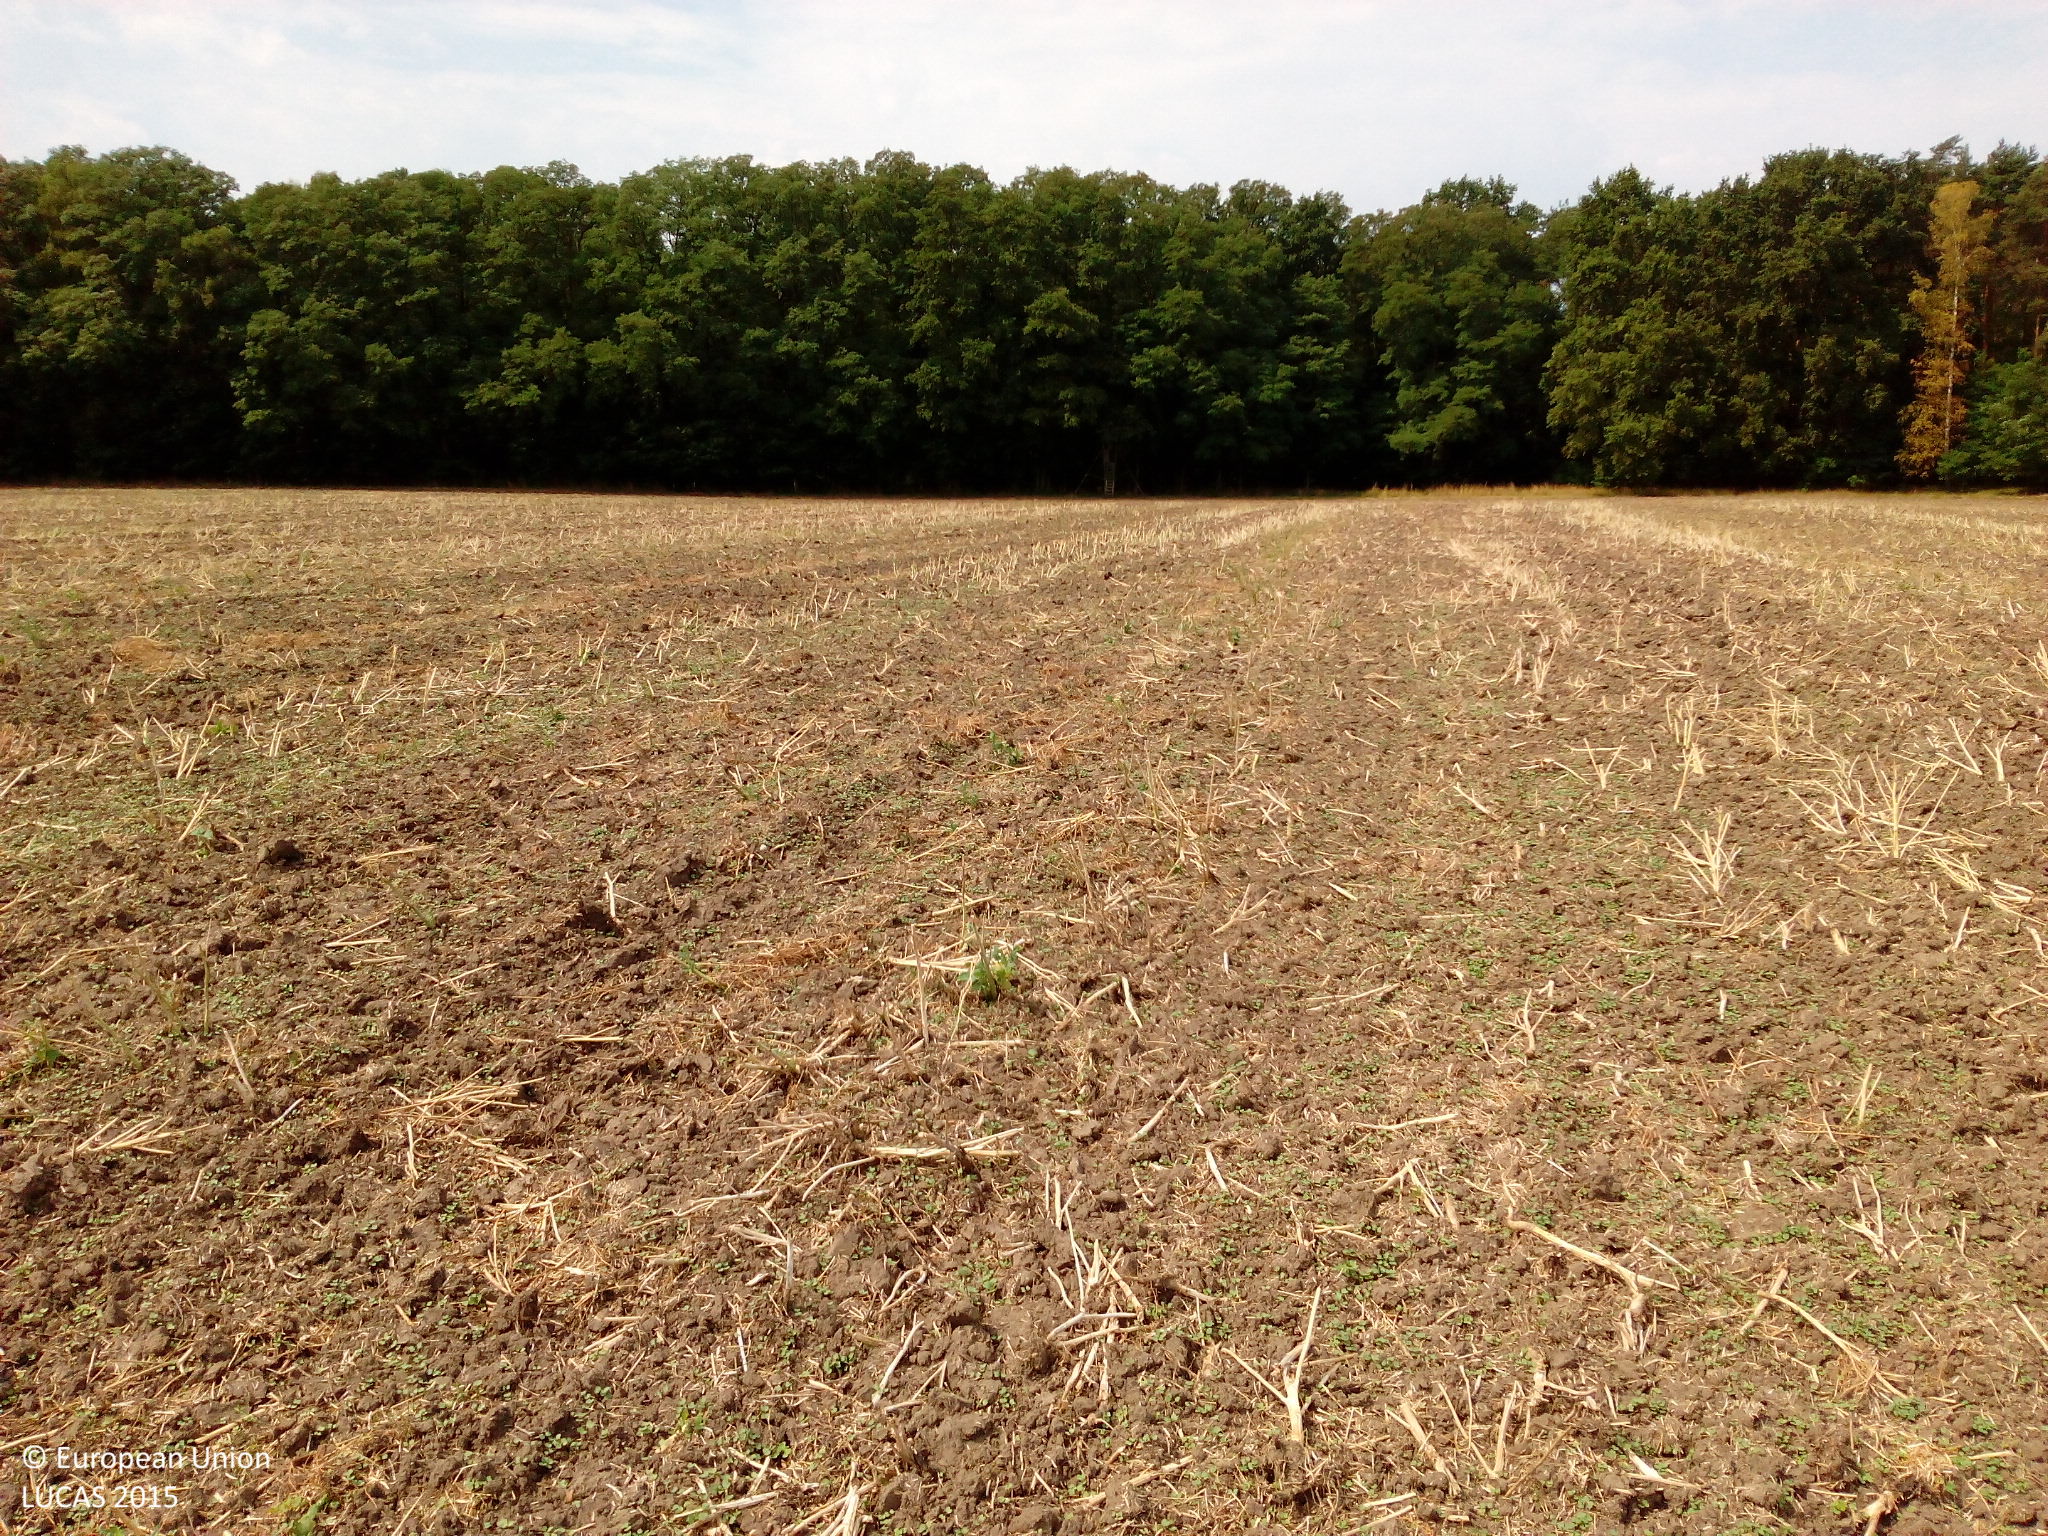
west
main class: Cropland
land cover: Rape and turnip rape
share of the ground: < 10 %
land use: Agriculture (excluding fallow land and kitchen gardens)
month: August
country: DE
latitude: 52.5576
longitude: 12.0498
